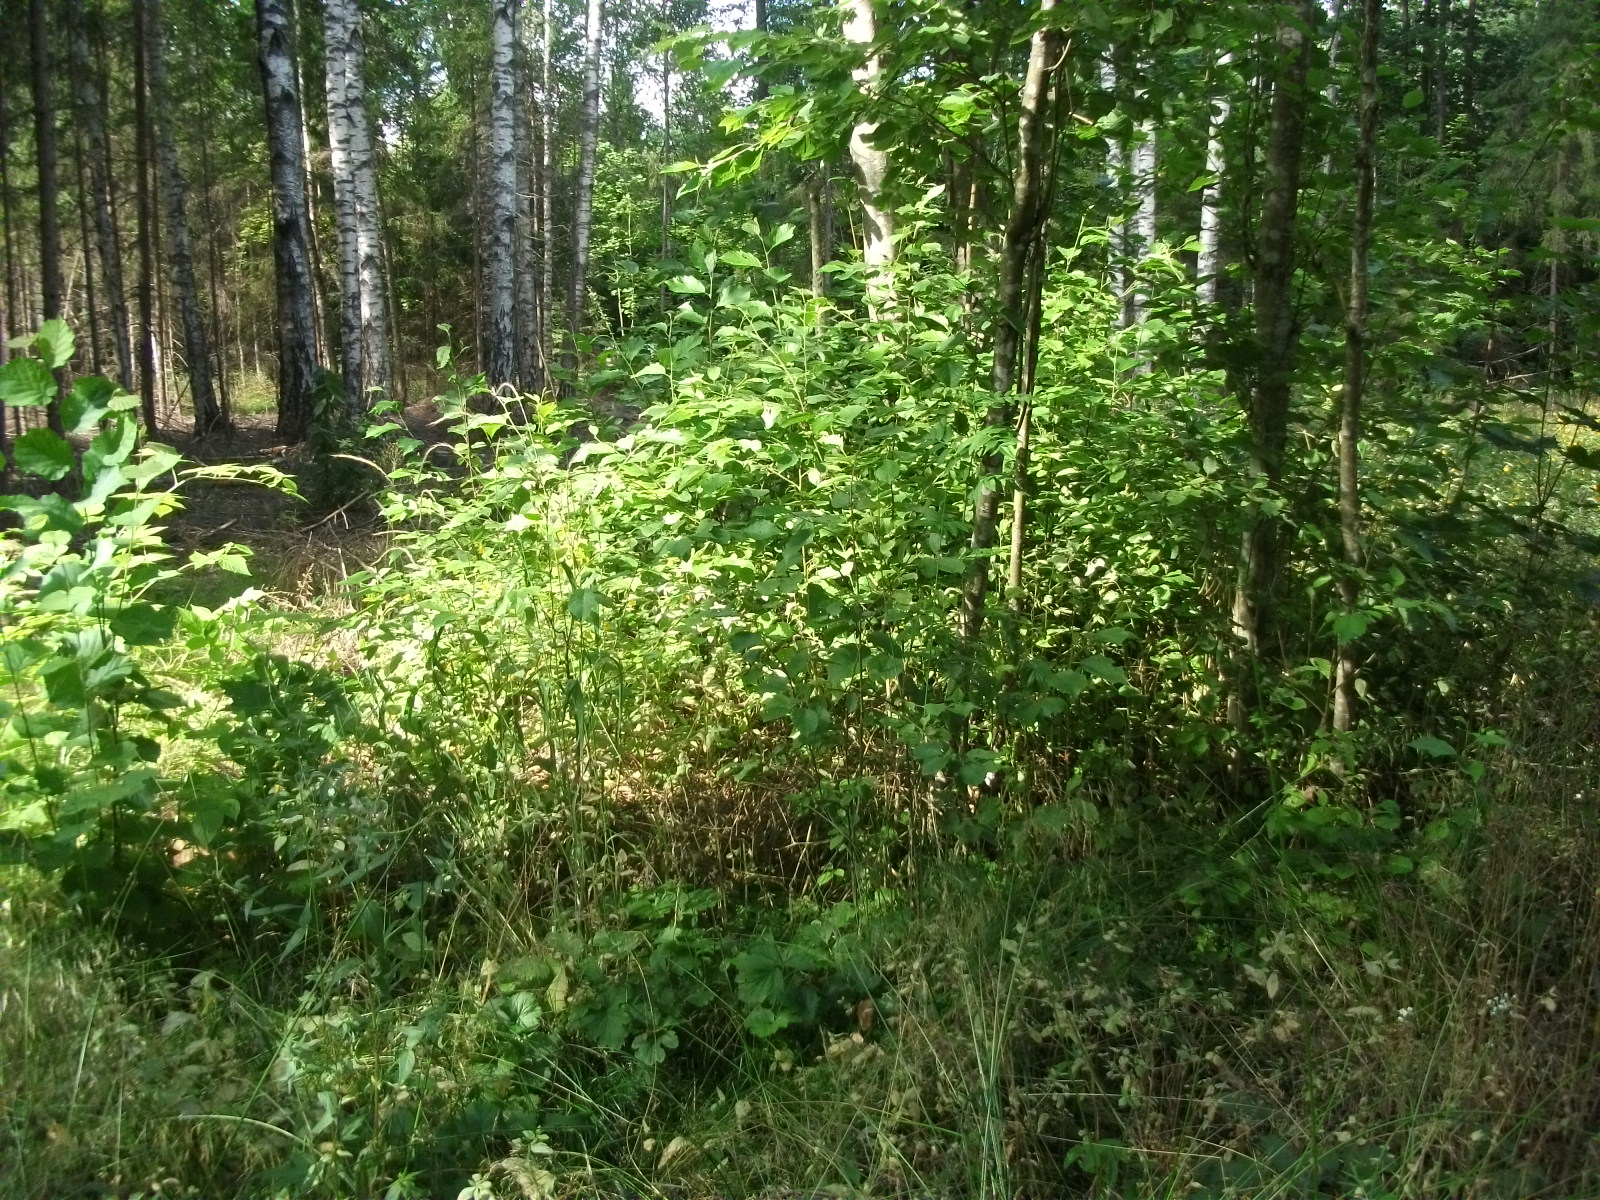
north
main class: Woodland
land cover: Spruce dominated mixed woodland
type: hemiboreal forest and nemoral coniferous forest and mixed broadleaved-coniferous forest
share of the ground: 50 - 75 %
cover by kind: coniferous forest trees 40 %, broadleaved forest trees 25 %, herbaceous plants 20 %, shrubs 15 %
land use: Forestry
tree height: > 5 m
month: August
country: LV
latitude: 57.1013
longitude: 26.6060
